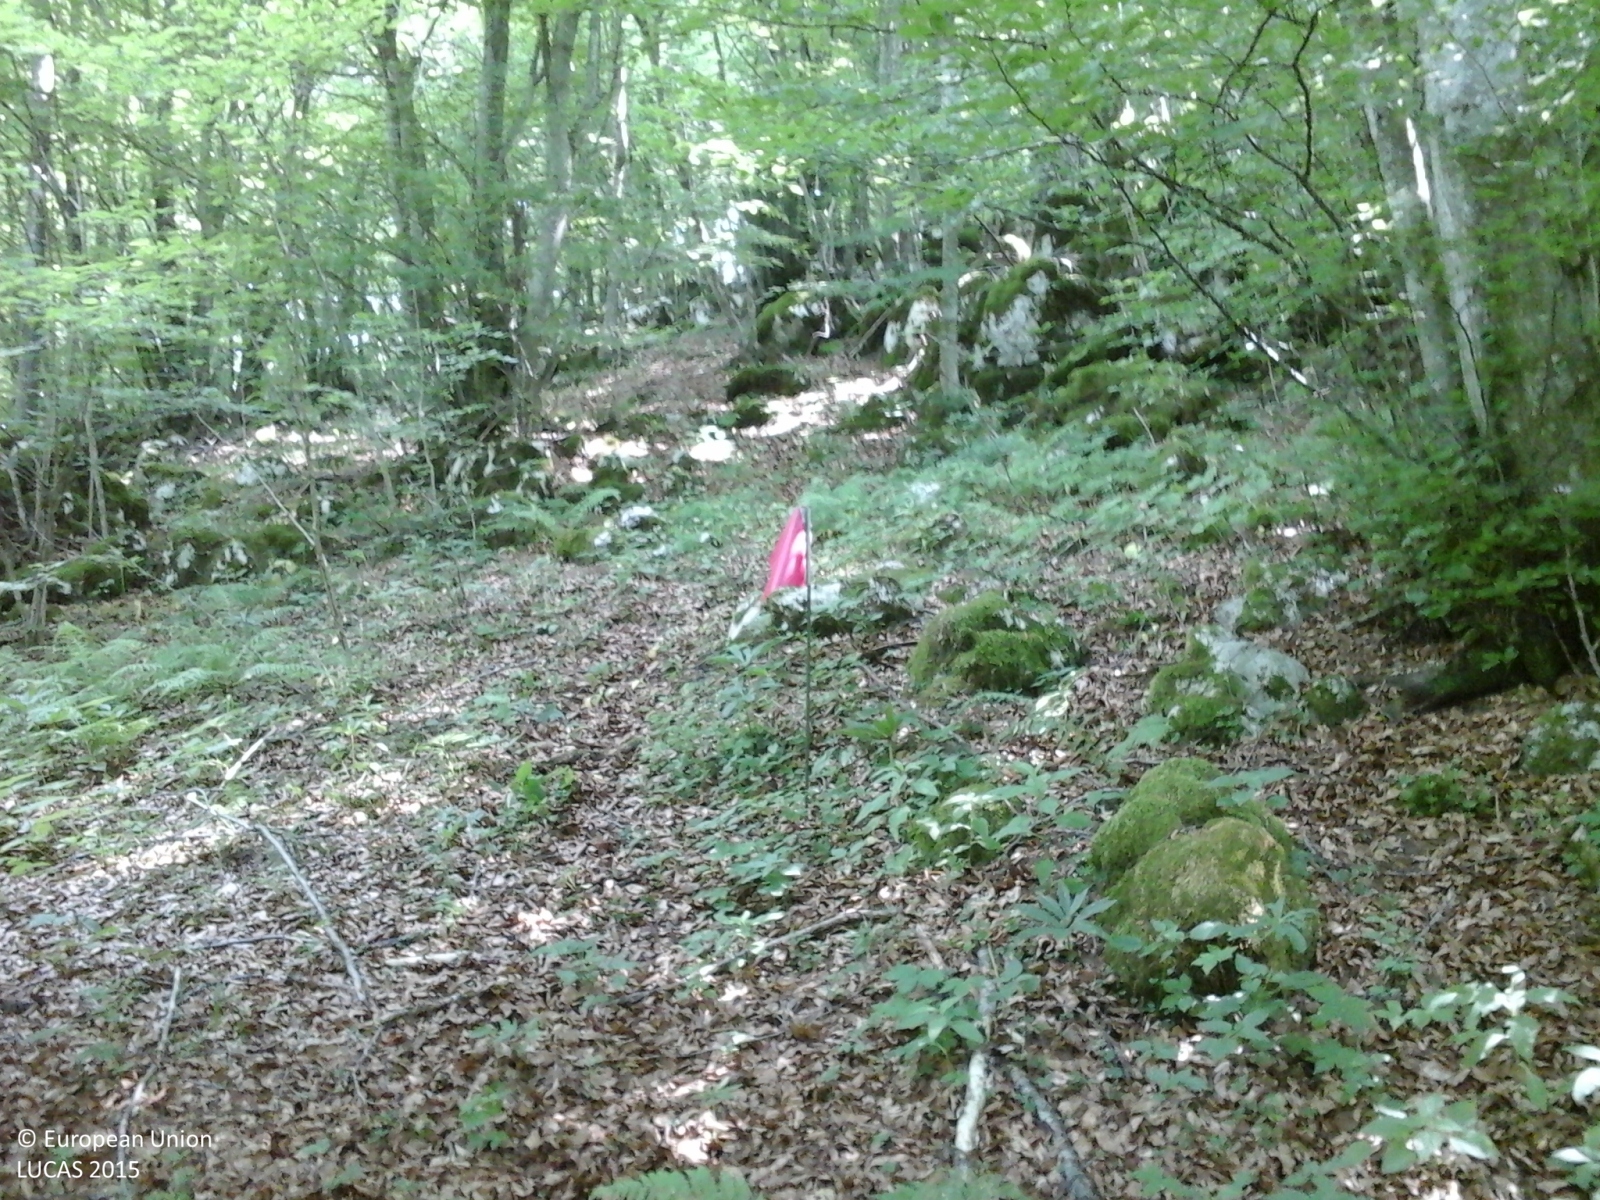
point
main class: Woodland
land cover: Broadleaved woodland
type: mountainous beech forest
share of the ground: > 75 %
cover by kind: broadleaved forest trees 100 %
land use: Forestry
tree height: > 5 m
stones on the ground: 25 - 50 %
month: June
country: IT
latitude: 45.8158
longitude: 11.6577
